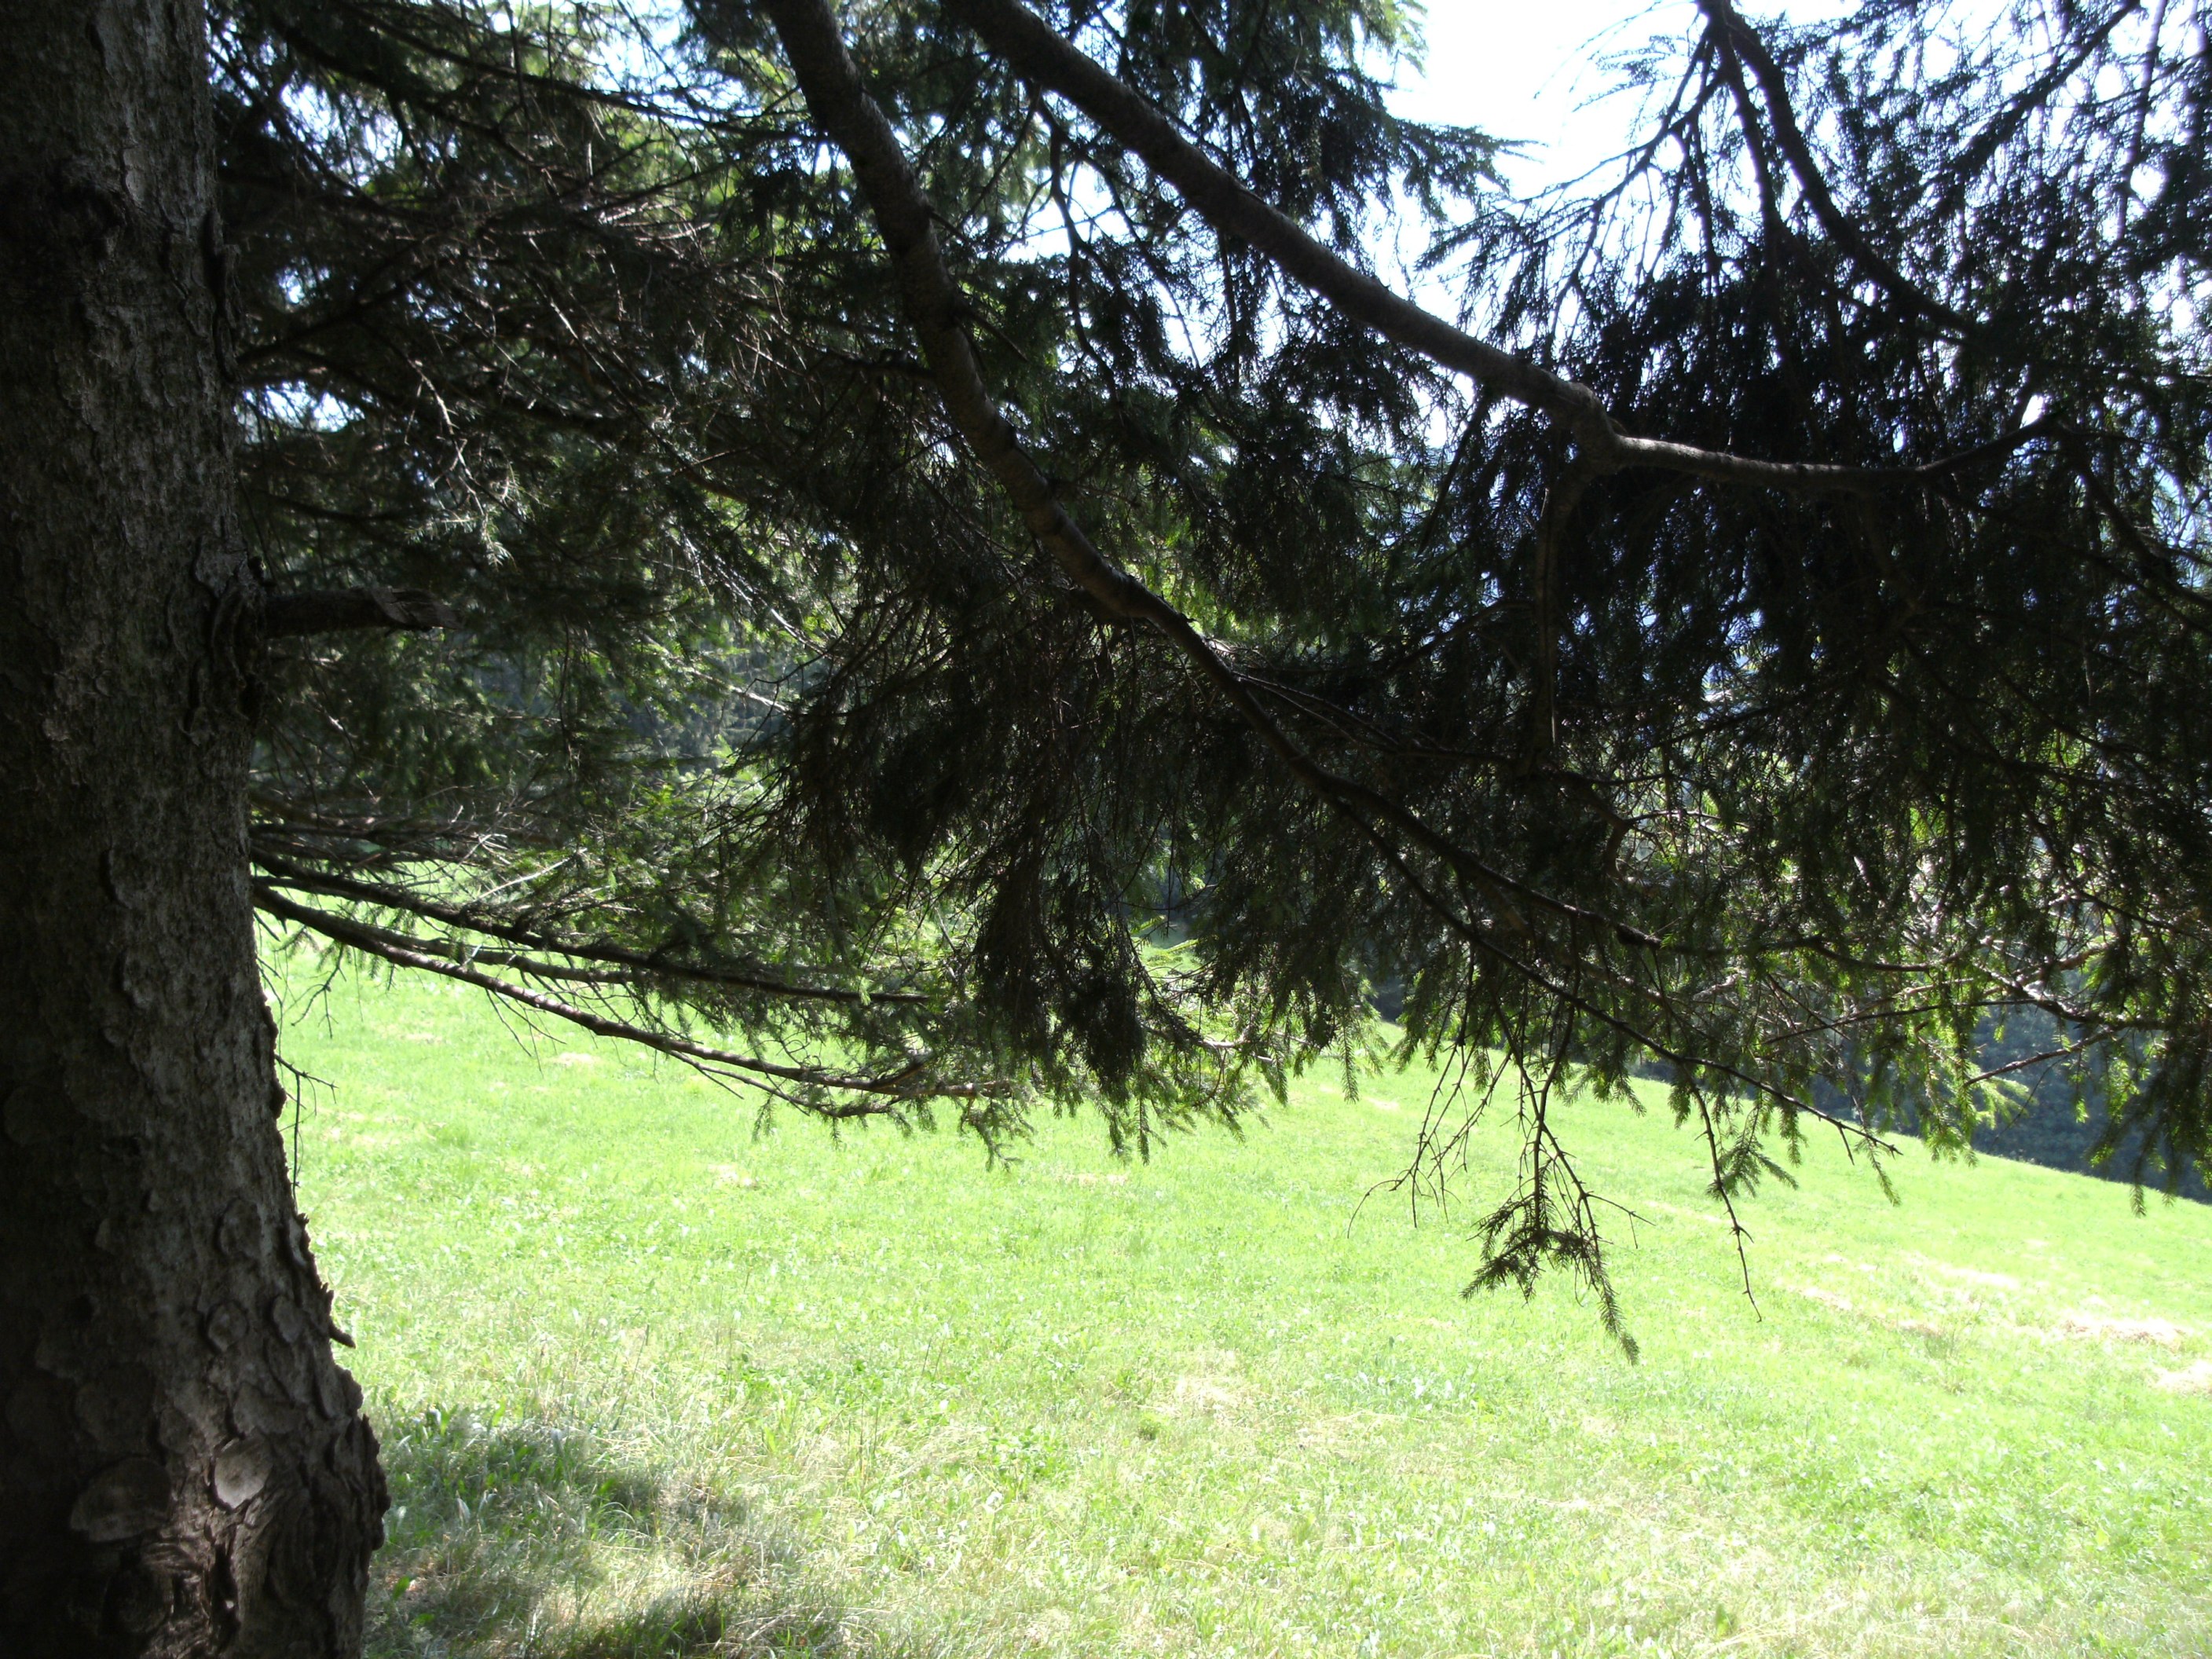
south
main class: Woodland
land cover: Spruce dominated coniferous woodland
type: alpine coniferous forest
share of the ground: > 75 %
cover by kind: coniferous forest trees 90 %, herbaceous plants 5 %, unconsolidated bare surface 5 %
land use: Forestry
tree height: > 5 m
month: July
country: AT
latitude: 46.7891
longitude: 14.7009
